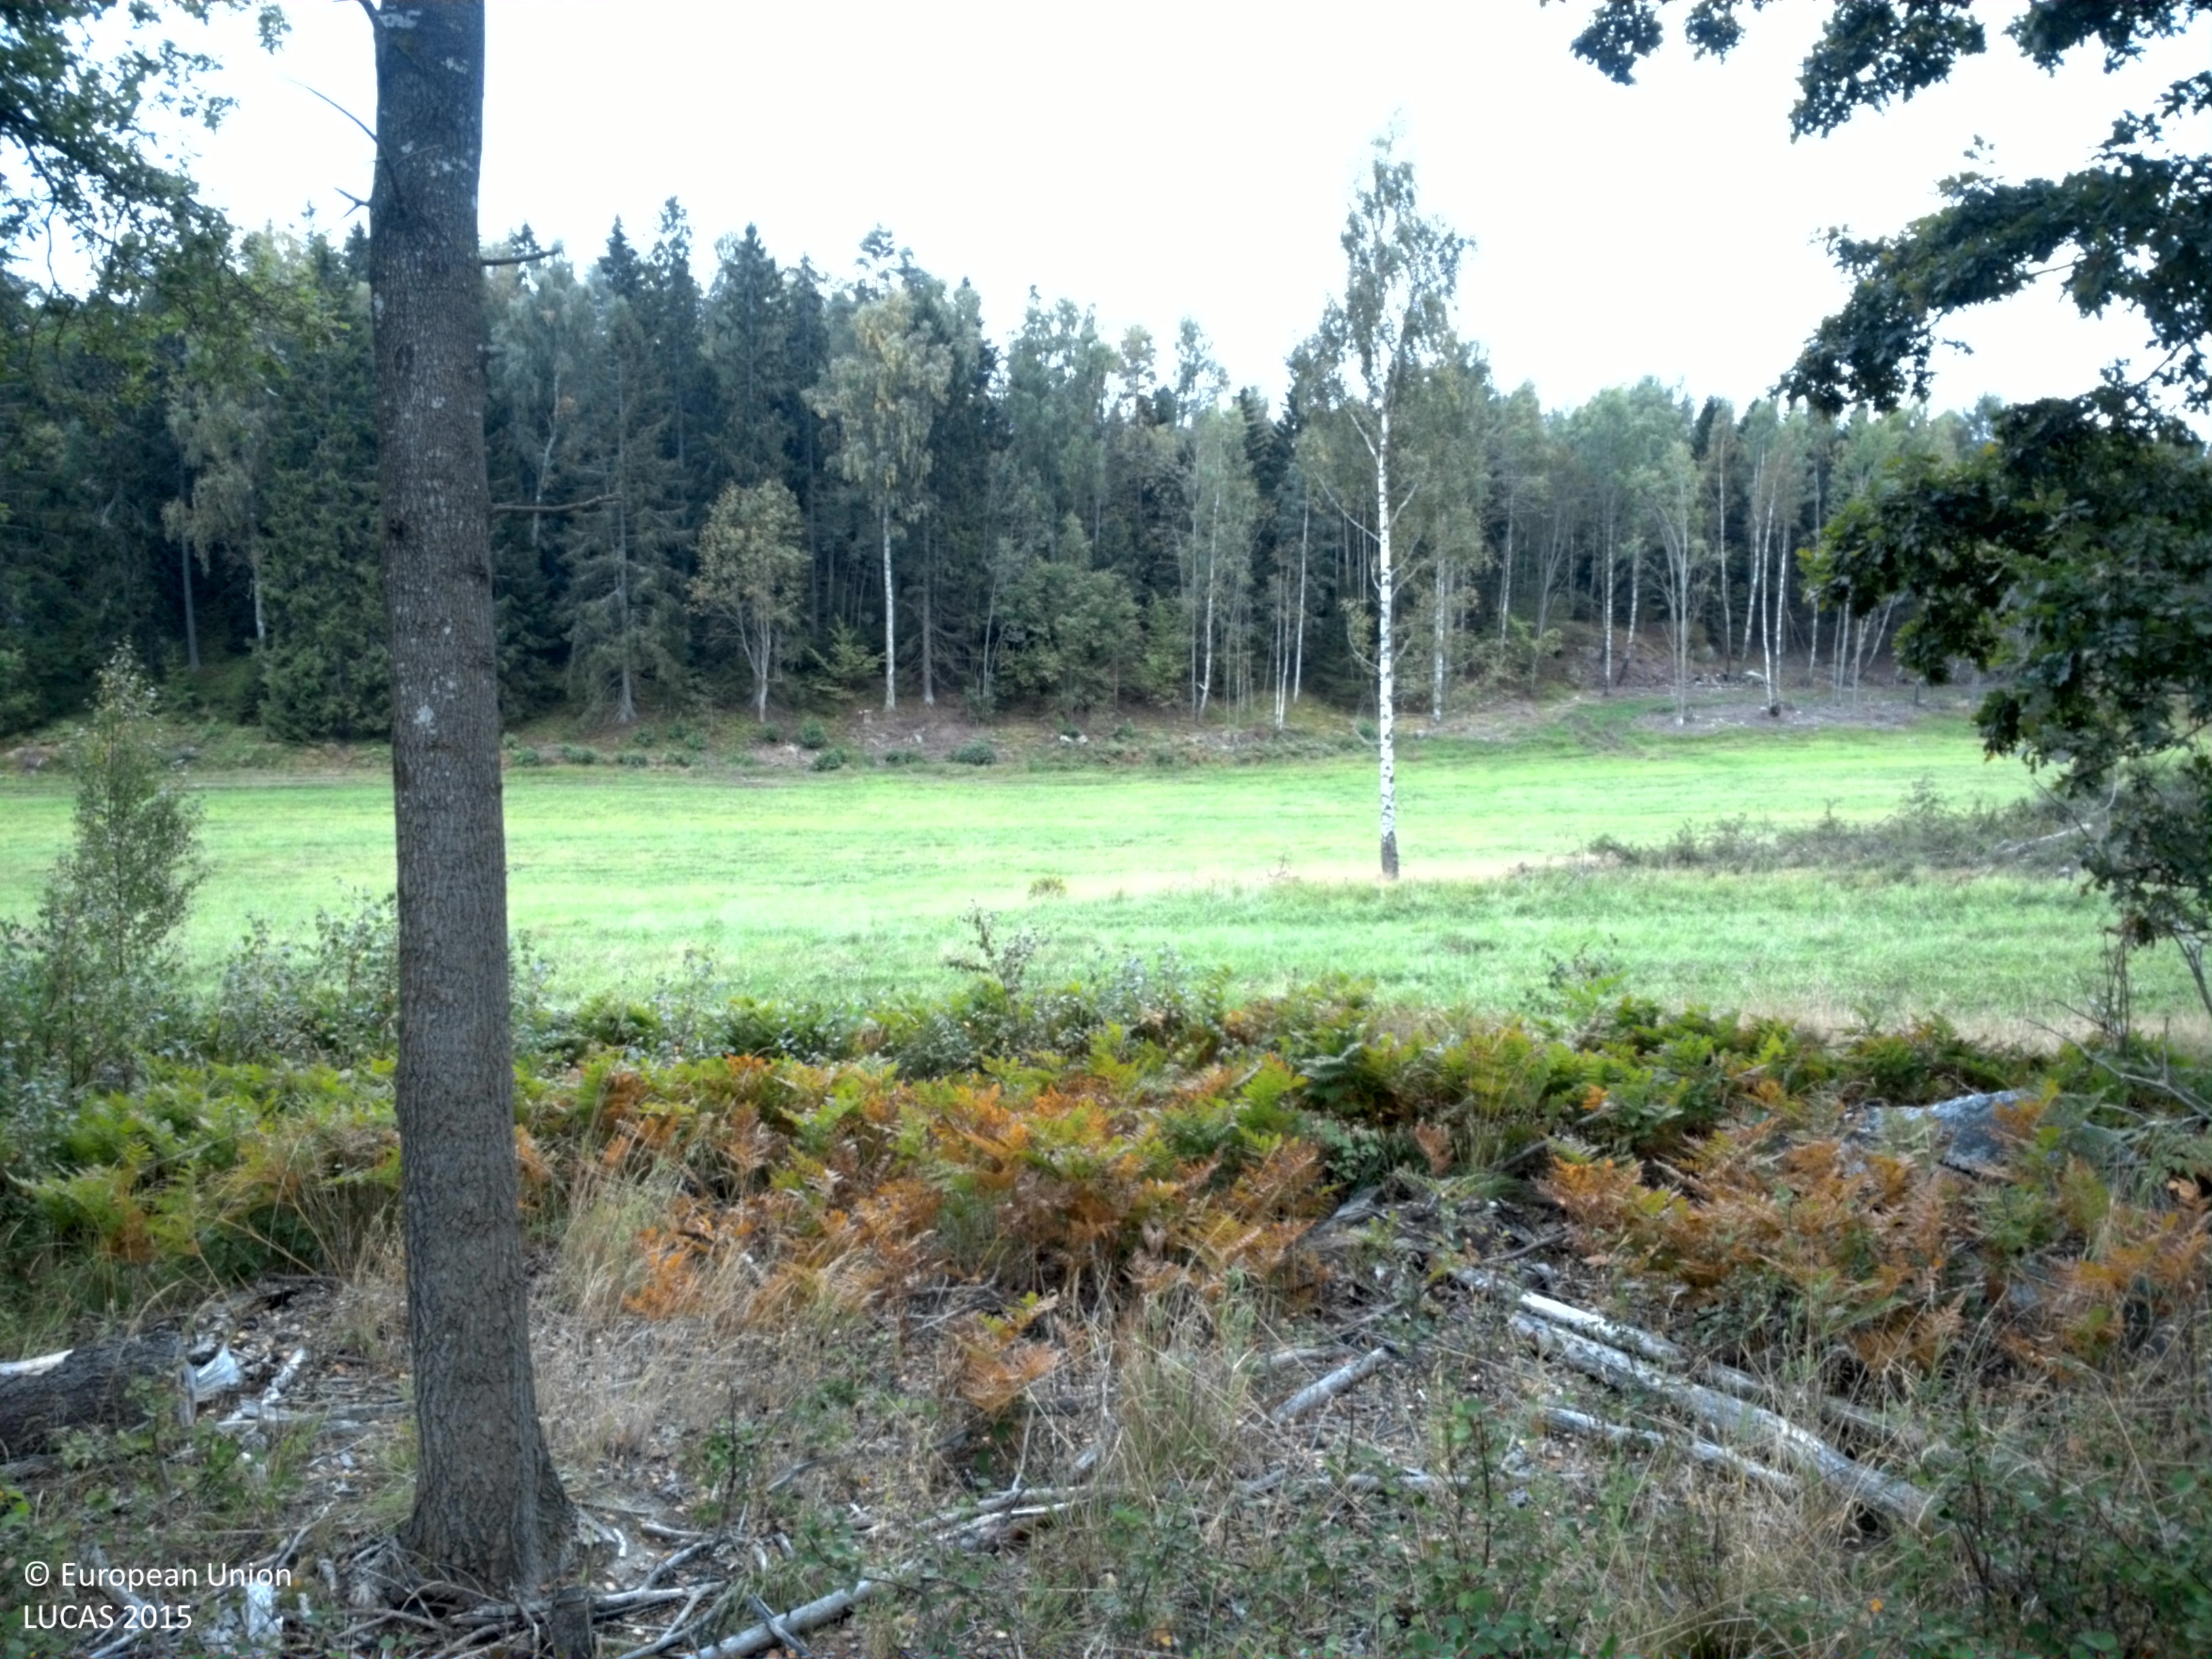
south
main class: Woodland
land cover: Broadleaved woodland
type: boreal forest
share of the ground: 50 - 75 %
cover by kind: broadleaved forest trees 50 %, herbaceous plants 40 %, coniferous forest trees 10 %
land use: Forestry
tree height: > 5 m
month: September
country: SE
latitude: 59.2953
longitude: 18.4109
